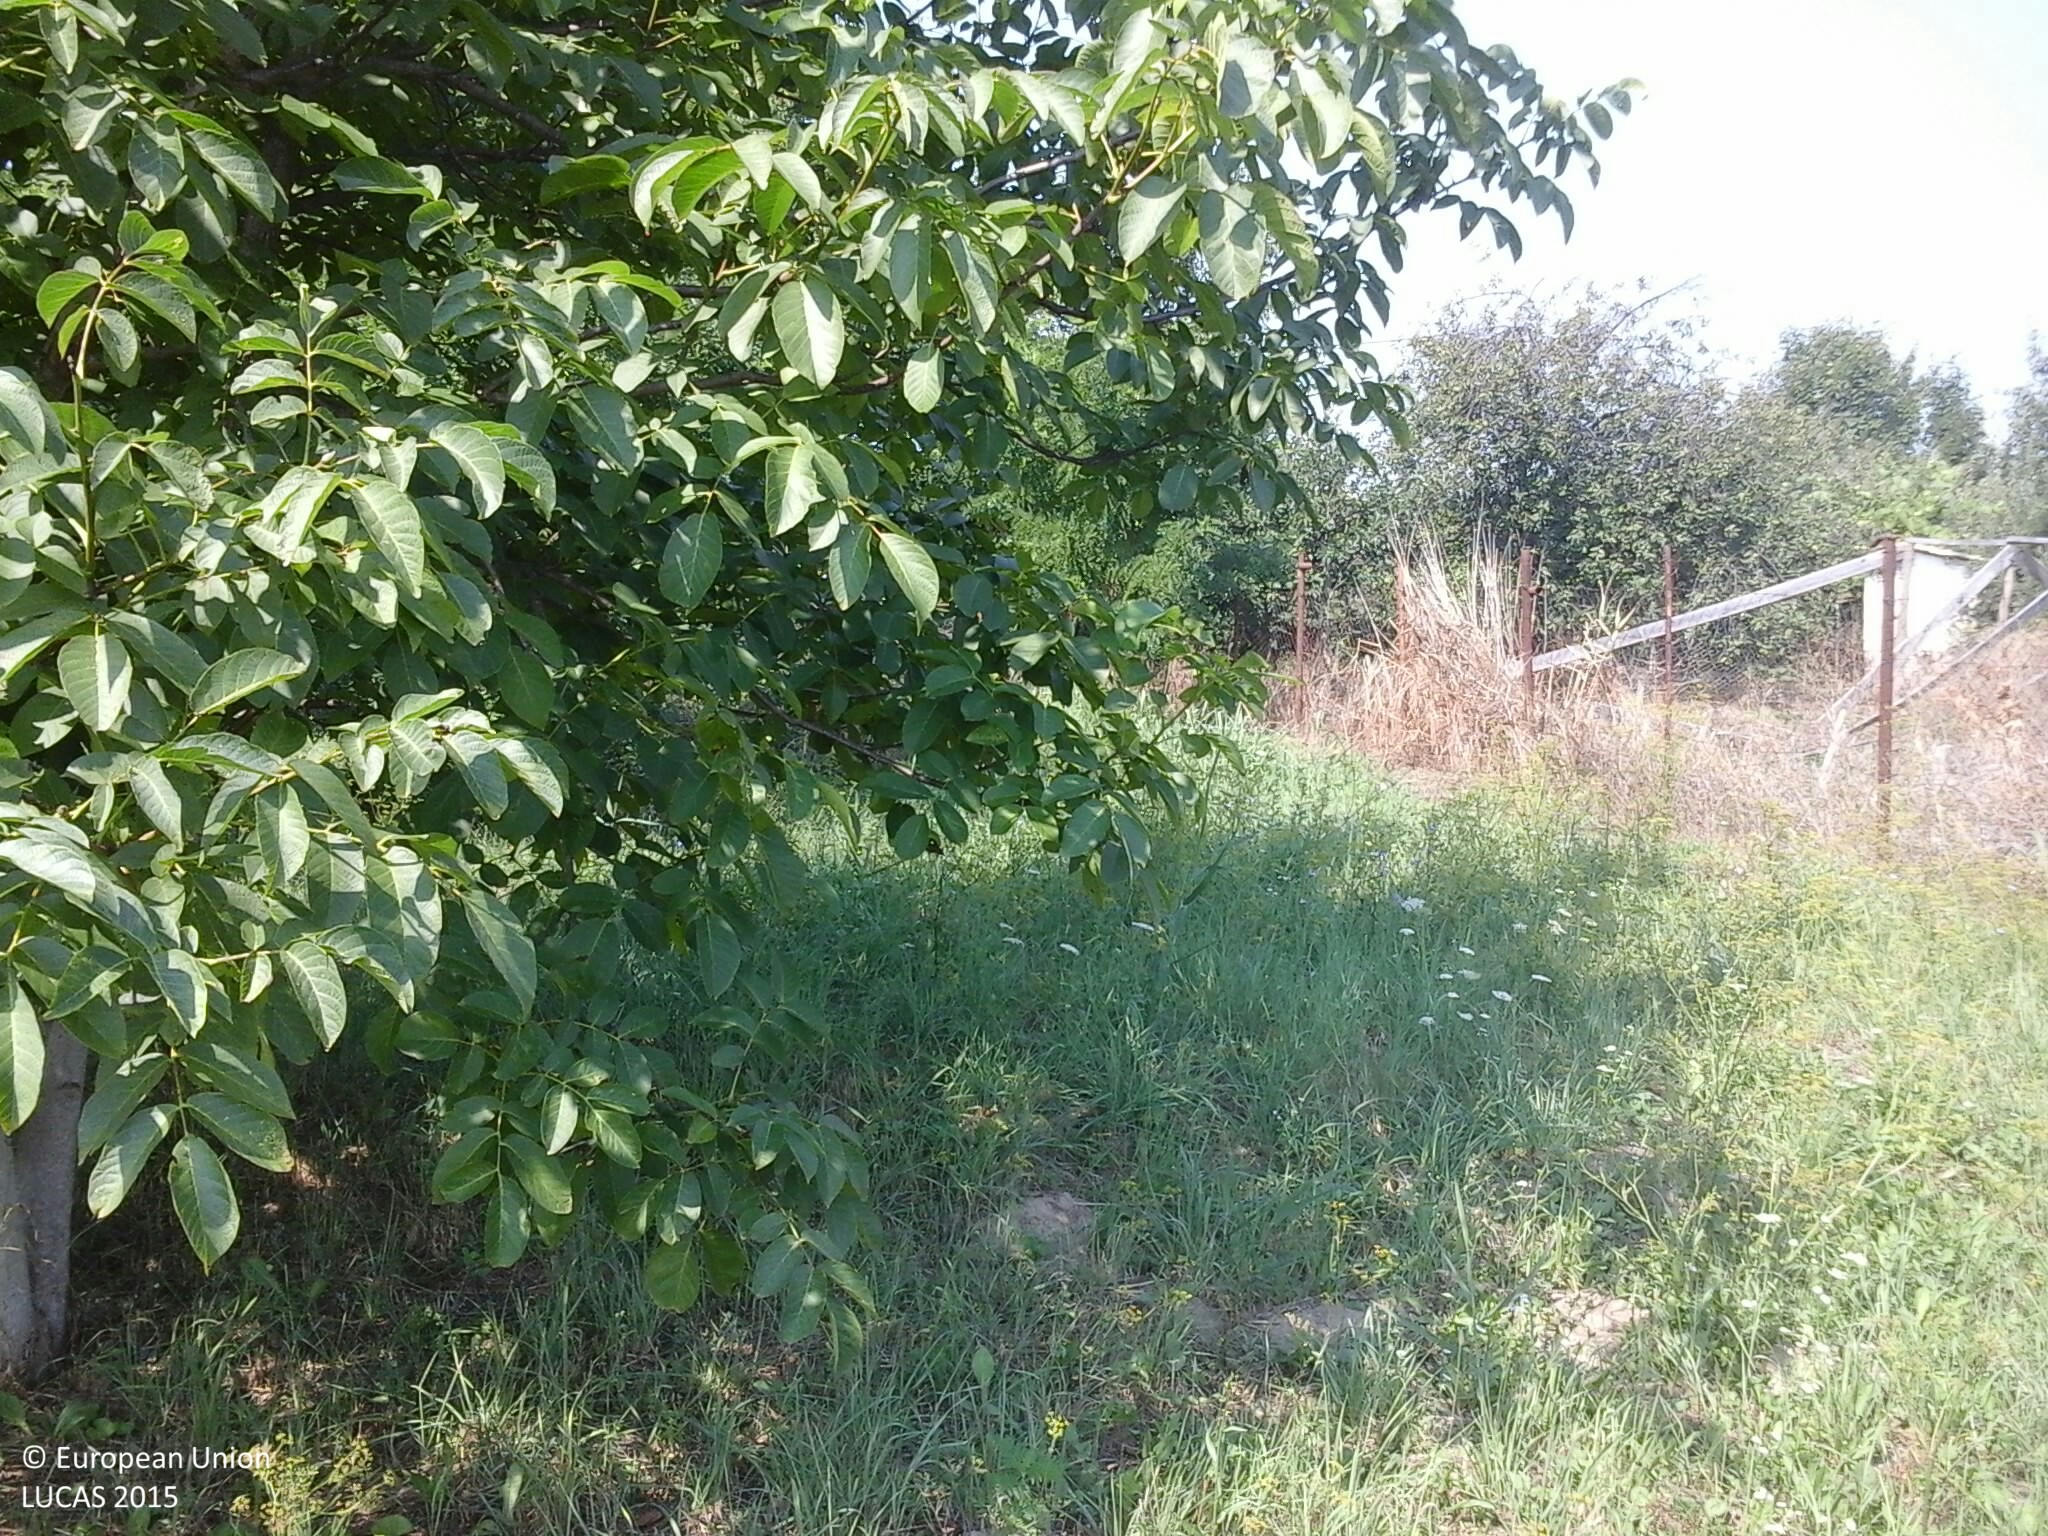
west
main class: Grassland
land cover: Grassland with sparse tree/shrub cover
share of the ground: > 75 %
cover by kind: herbaceous plants 95 %, broadleaved forest trees 5 %
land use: Abandoned areas
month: August
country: HU
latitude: 46.0510
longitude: 18.2399
